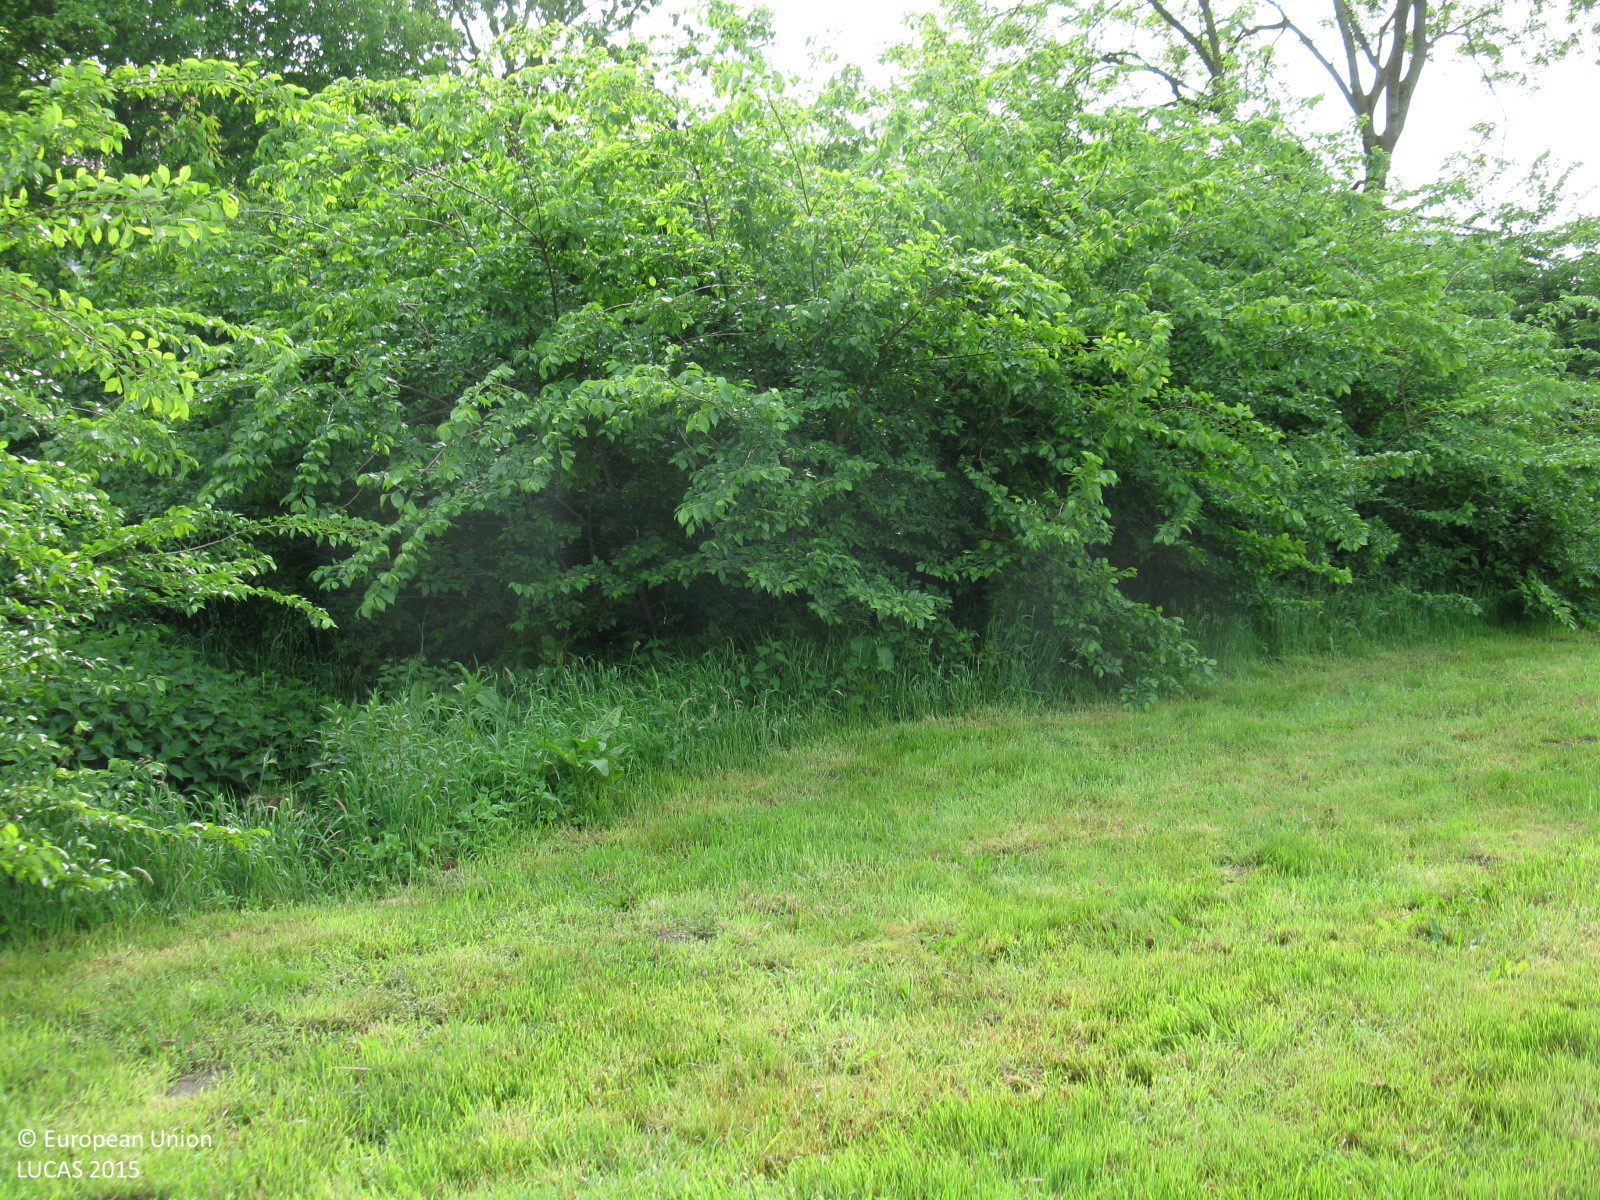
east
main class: Grassland
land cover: Grassland without tree/shrub cover
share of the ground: > 75 %
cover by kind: herbaceous plants 100 %
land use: Residential
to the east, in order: Grassland without tree/shrub cover; Artificial constructions in urban areas
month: June
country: DE
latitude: 53.0488
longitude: 7.3303
